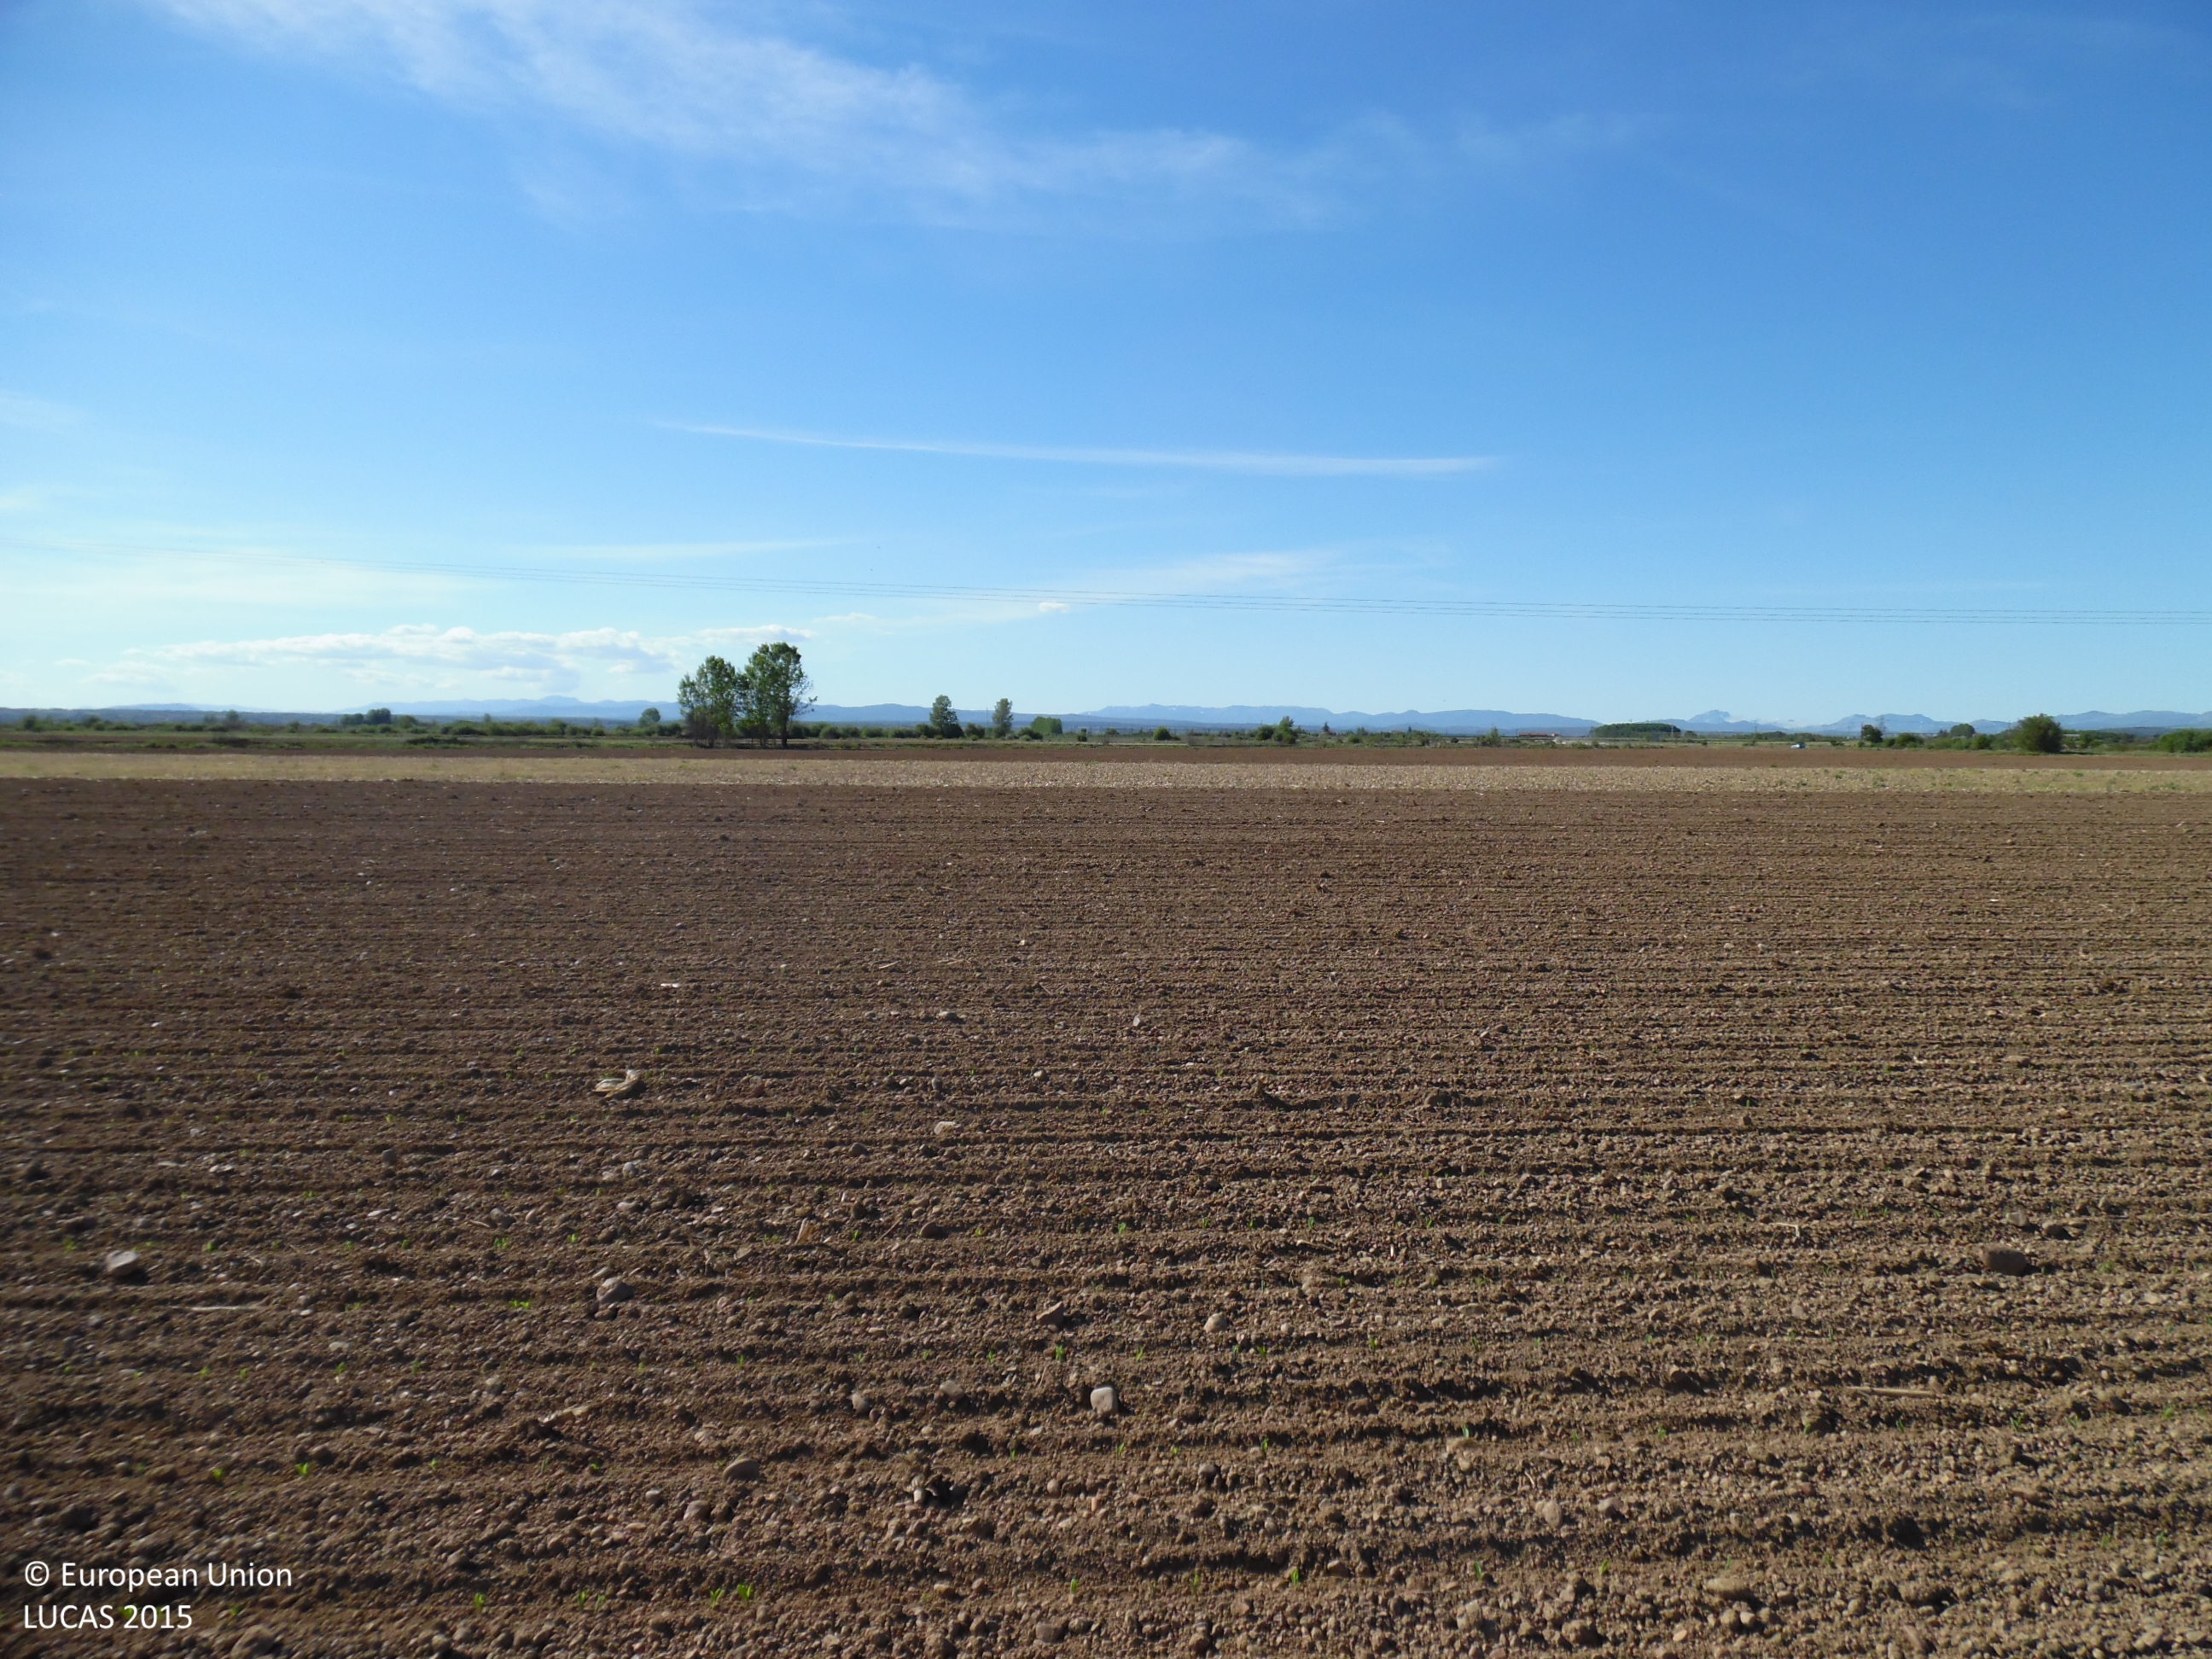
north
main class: Cropland
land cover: Maize
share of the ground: 50 - 75 %
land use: Agriculture (excluding fallow land and kitchen gardens)
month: May
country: ES
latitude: 42.5614
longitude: -5.8022
